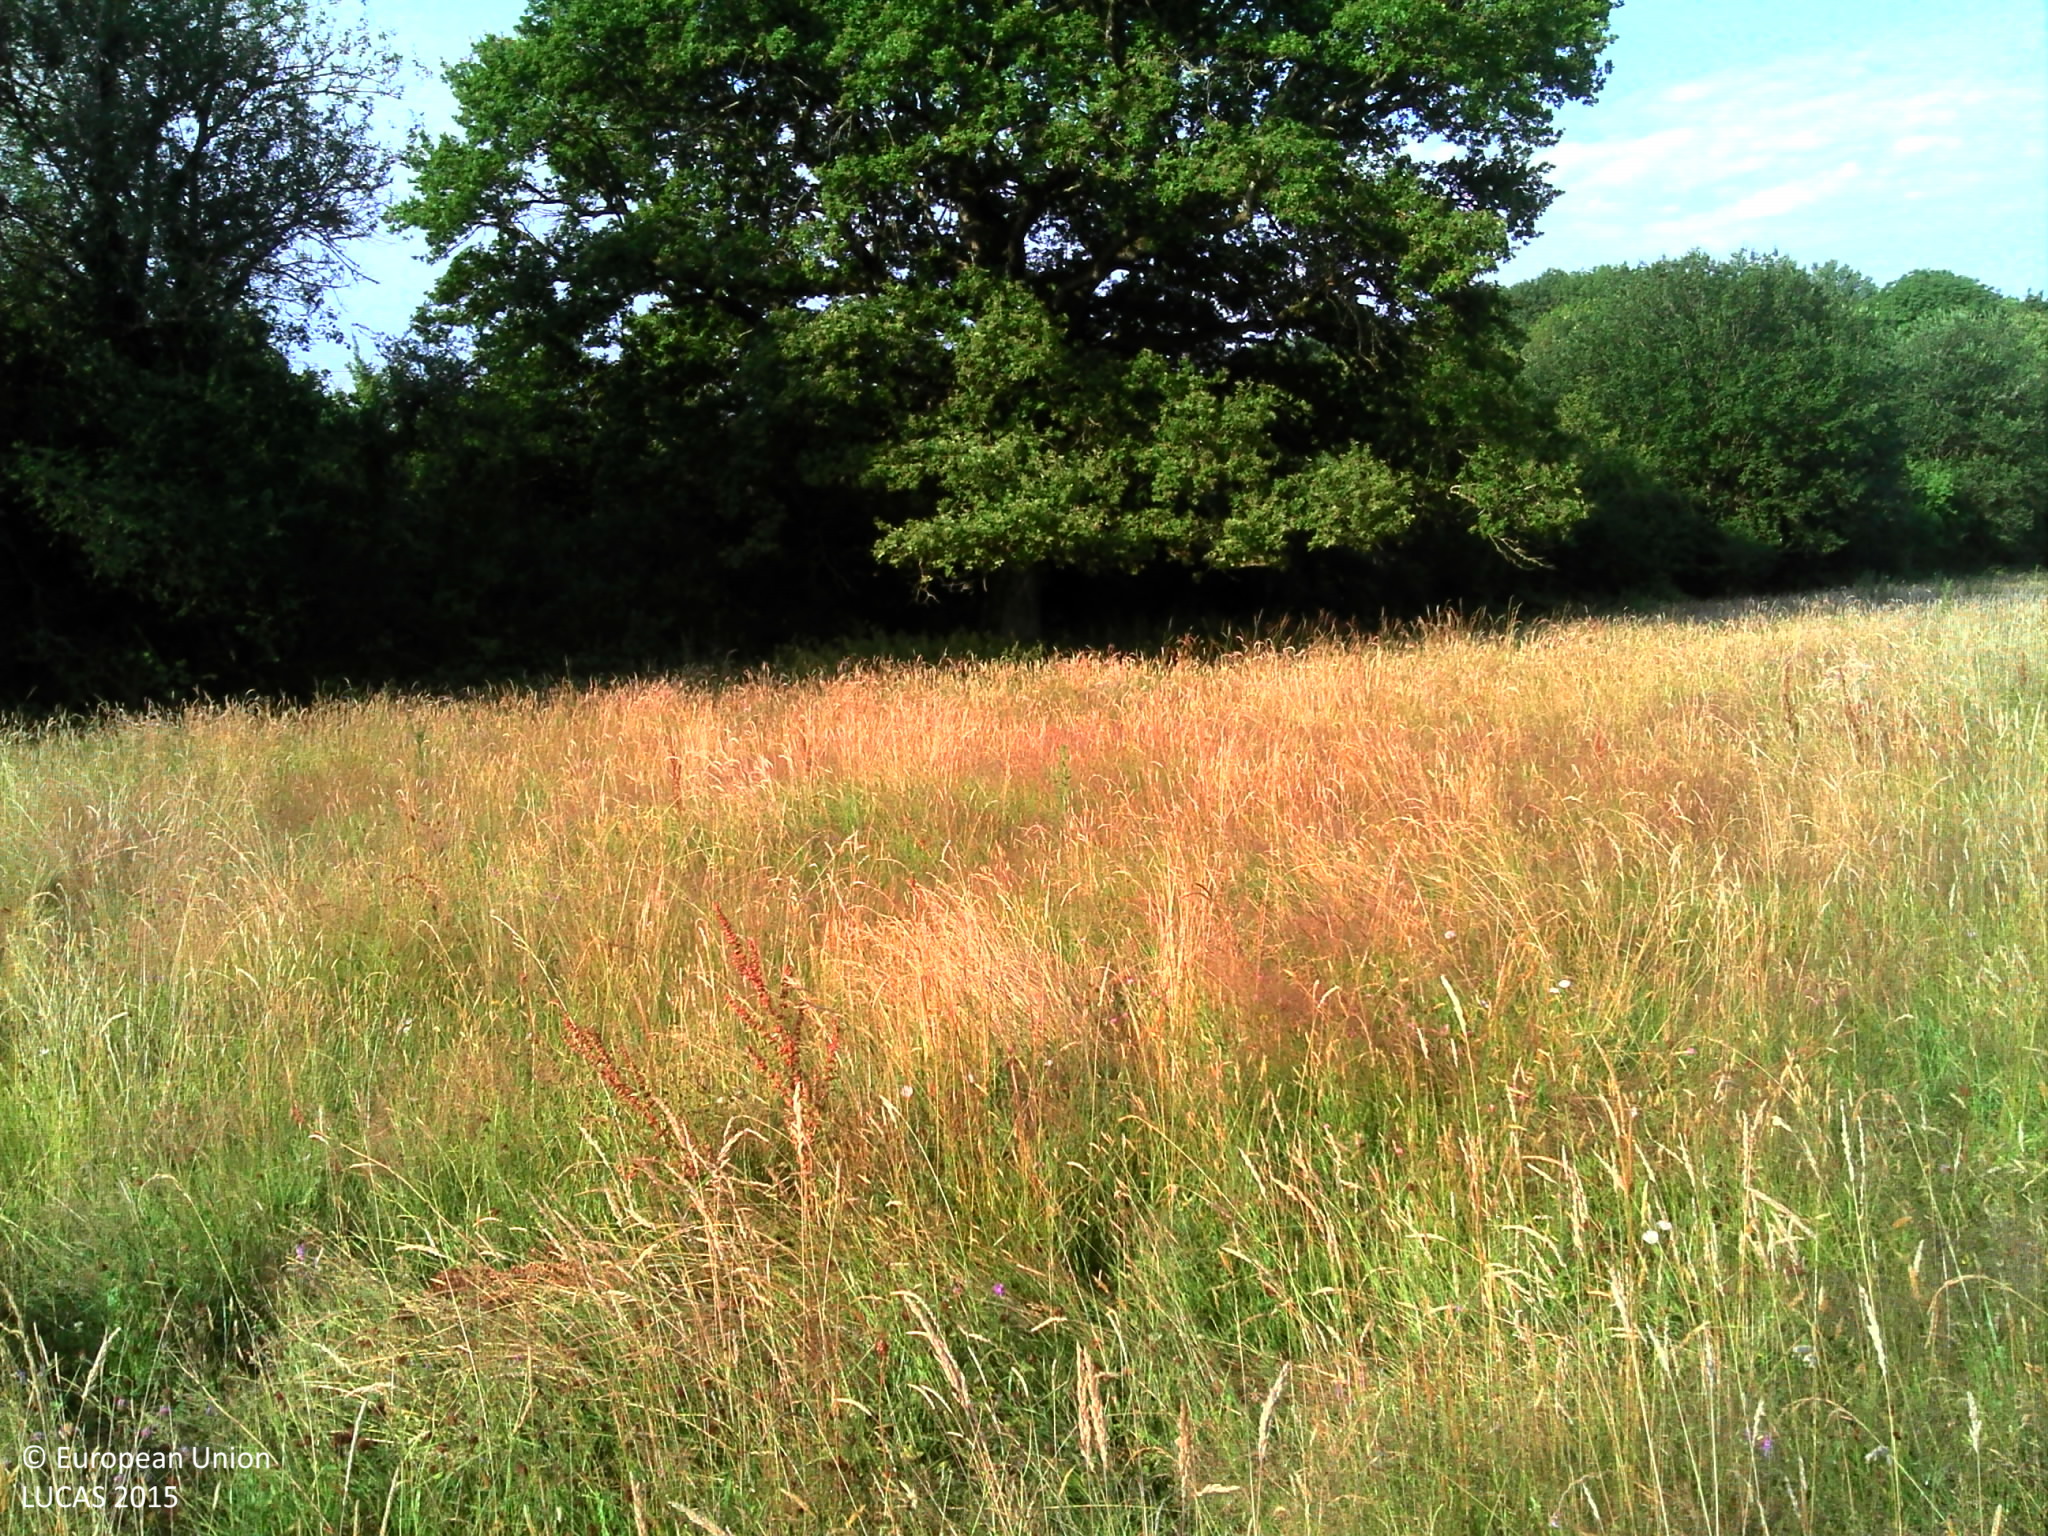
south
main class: Grassland
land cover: Grassland without tree/shrub cover
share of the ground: > 75 %
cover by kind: herbaceous plants 100 %
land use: Agriculture (excluding fallow land and kitchen gardens)
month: July
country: FR
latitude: 47.1873
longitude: 3.5702
